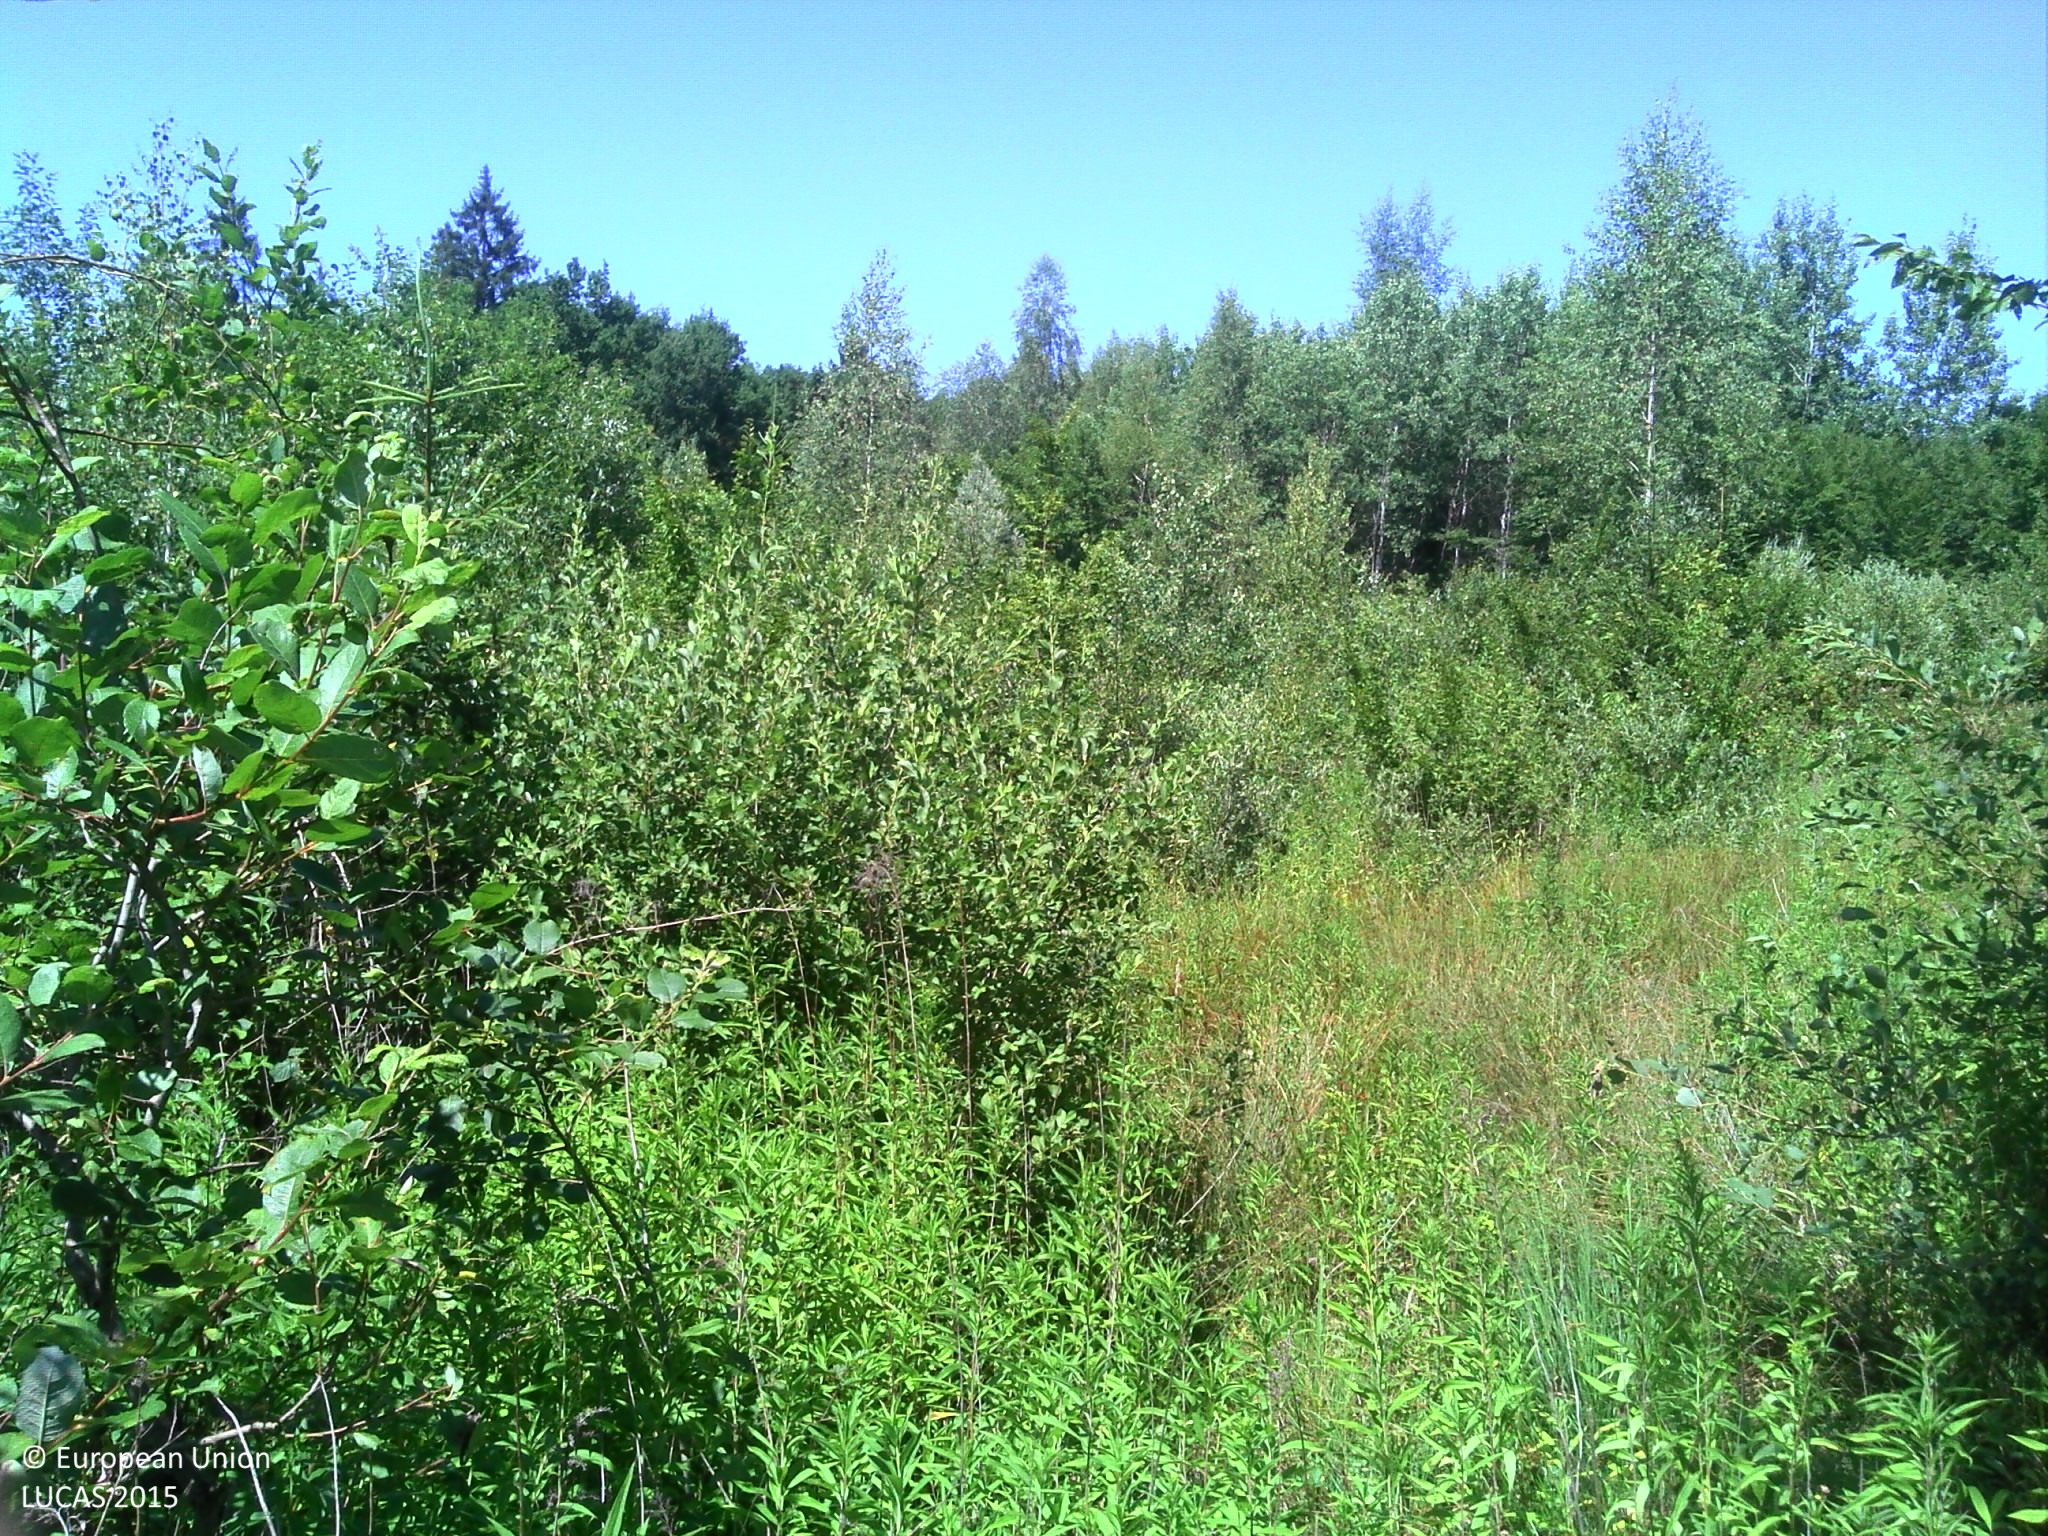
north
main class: Shrubland
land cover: Shrubland with sparse tree cover
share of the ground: > 75 %
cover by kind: shrubs 60 %, herbaceous plants 35 %, broadleaved forest trees 5 %
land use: Abandoned areas
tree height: < 5 m
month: July
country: FR
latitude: 46.3089
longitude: 6.4065
